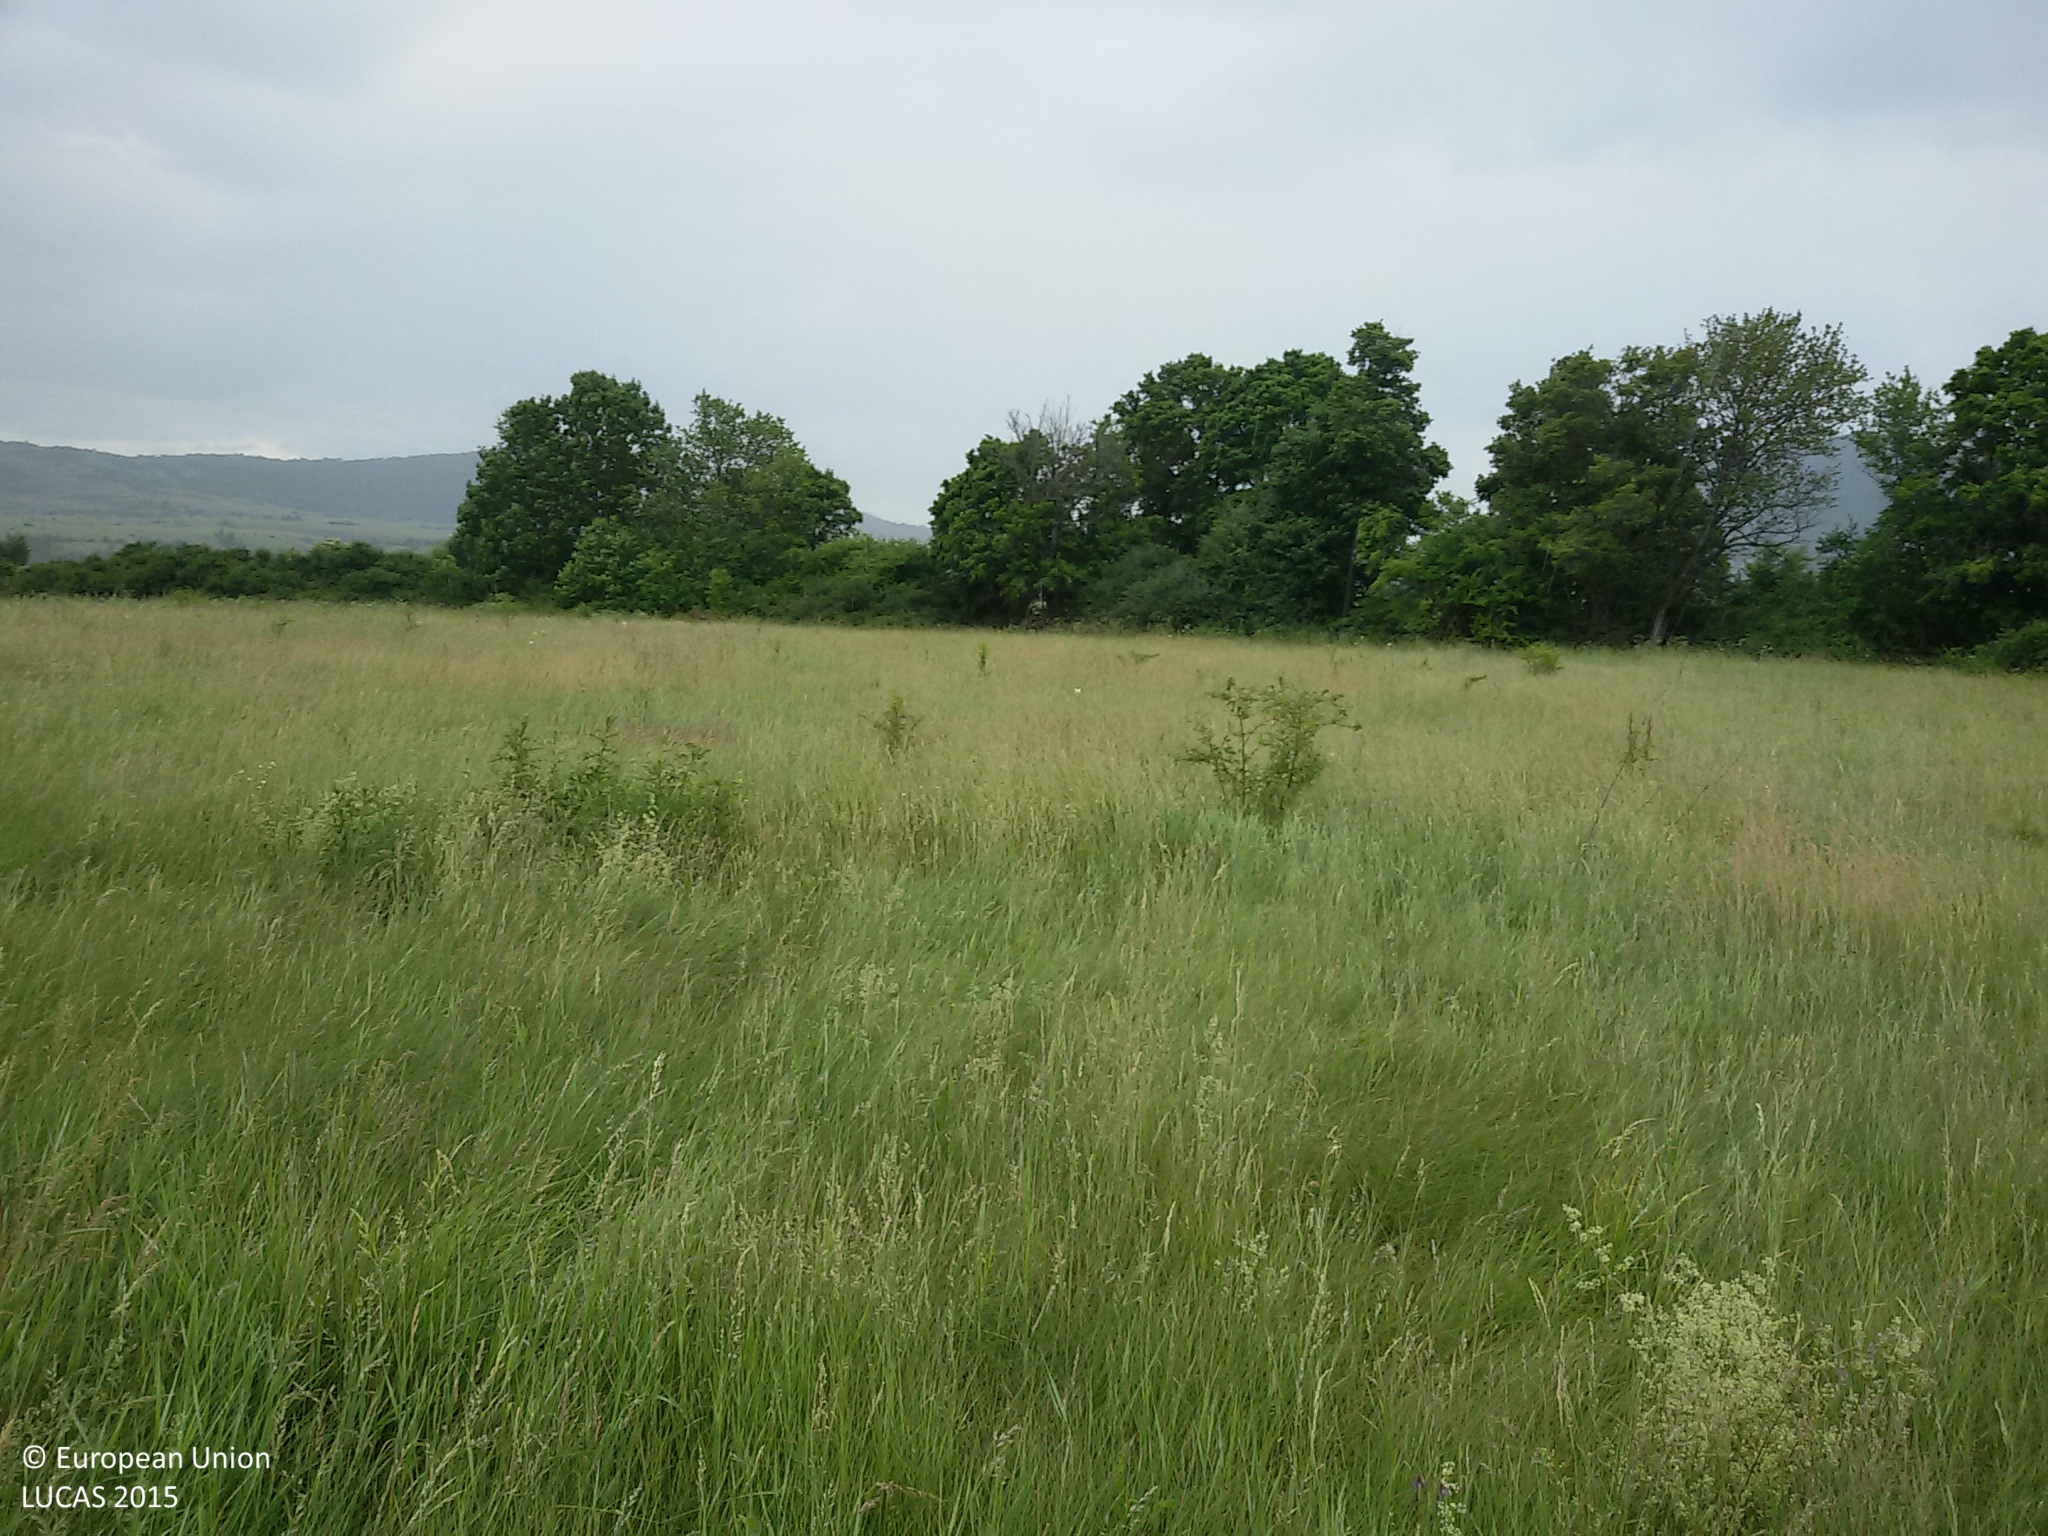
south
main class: Grassland
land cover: Grassland without tree/shrub cover
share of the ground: > 75 %
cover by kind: herbaceous plants 95 %, unconsolidated bare surface 5 %
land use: Agriculture (excluding fallow land and kitchen gardens)
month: June
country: HR
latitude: 44.6136
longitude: 15.6266
